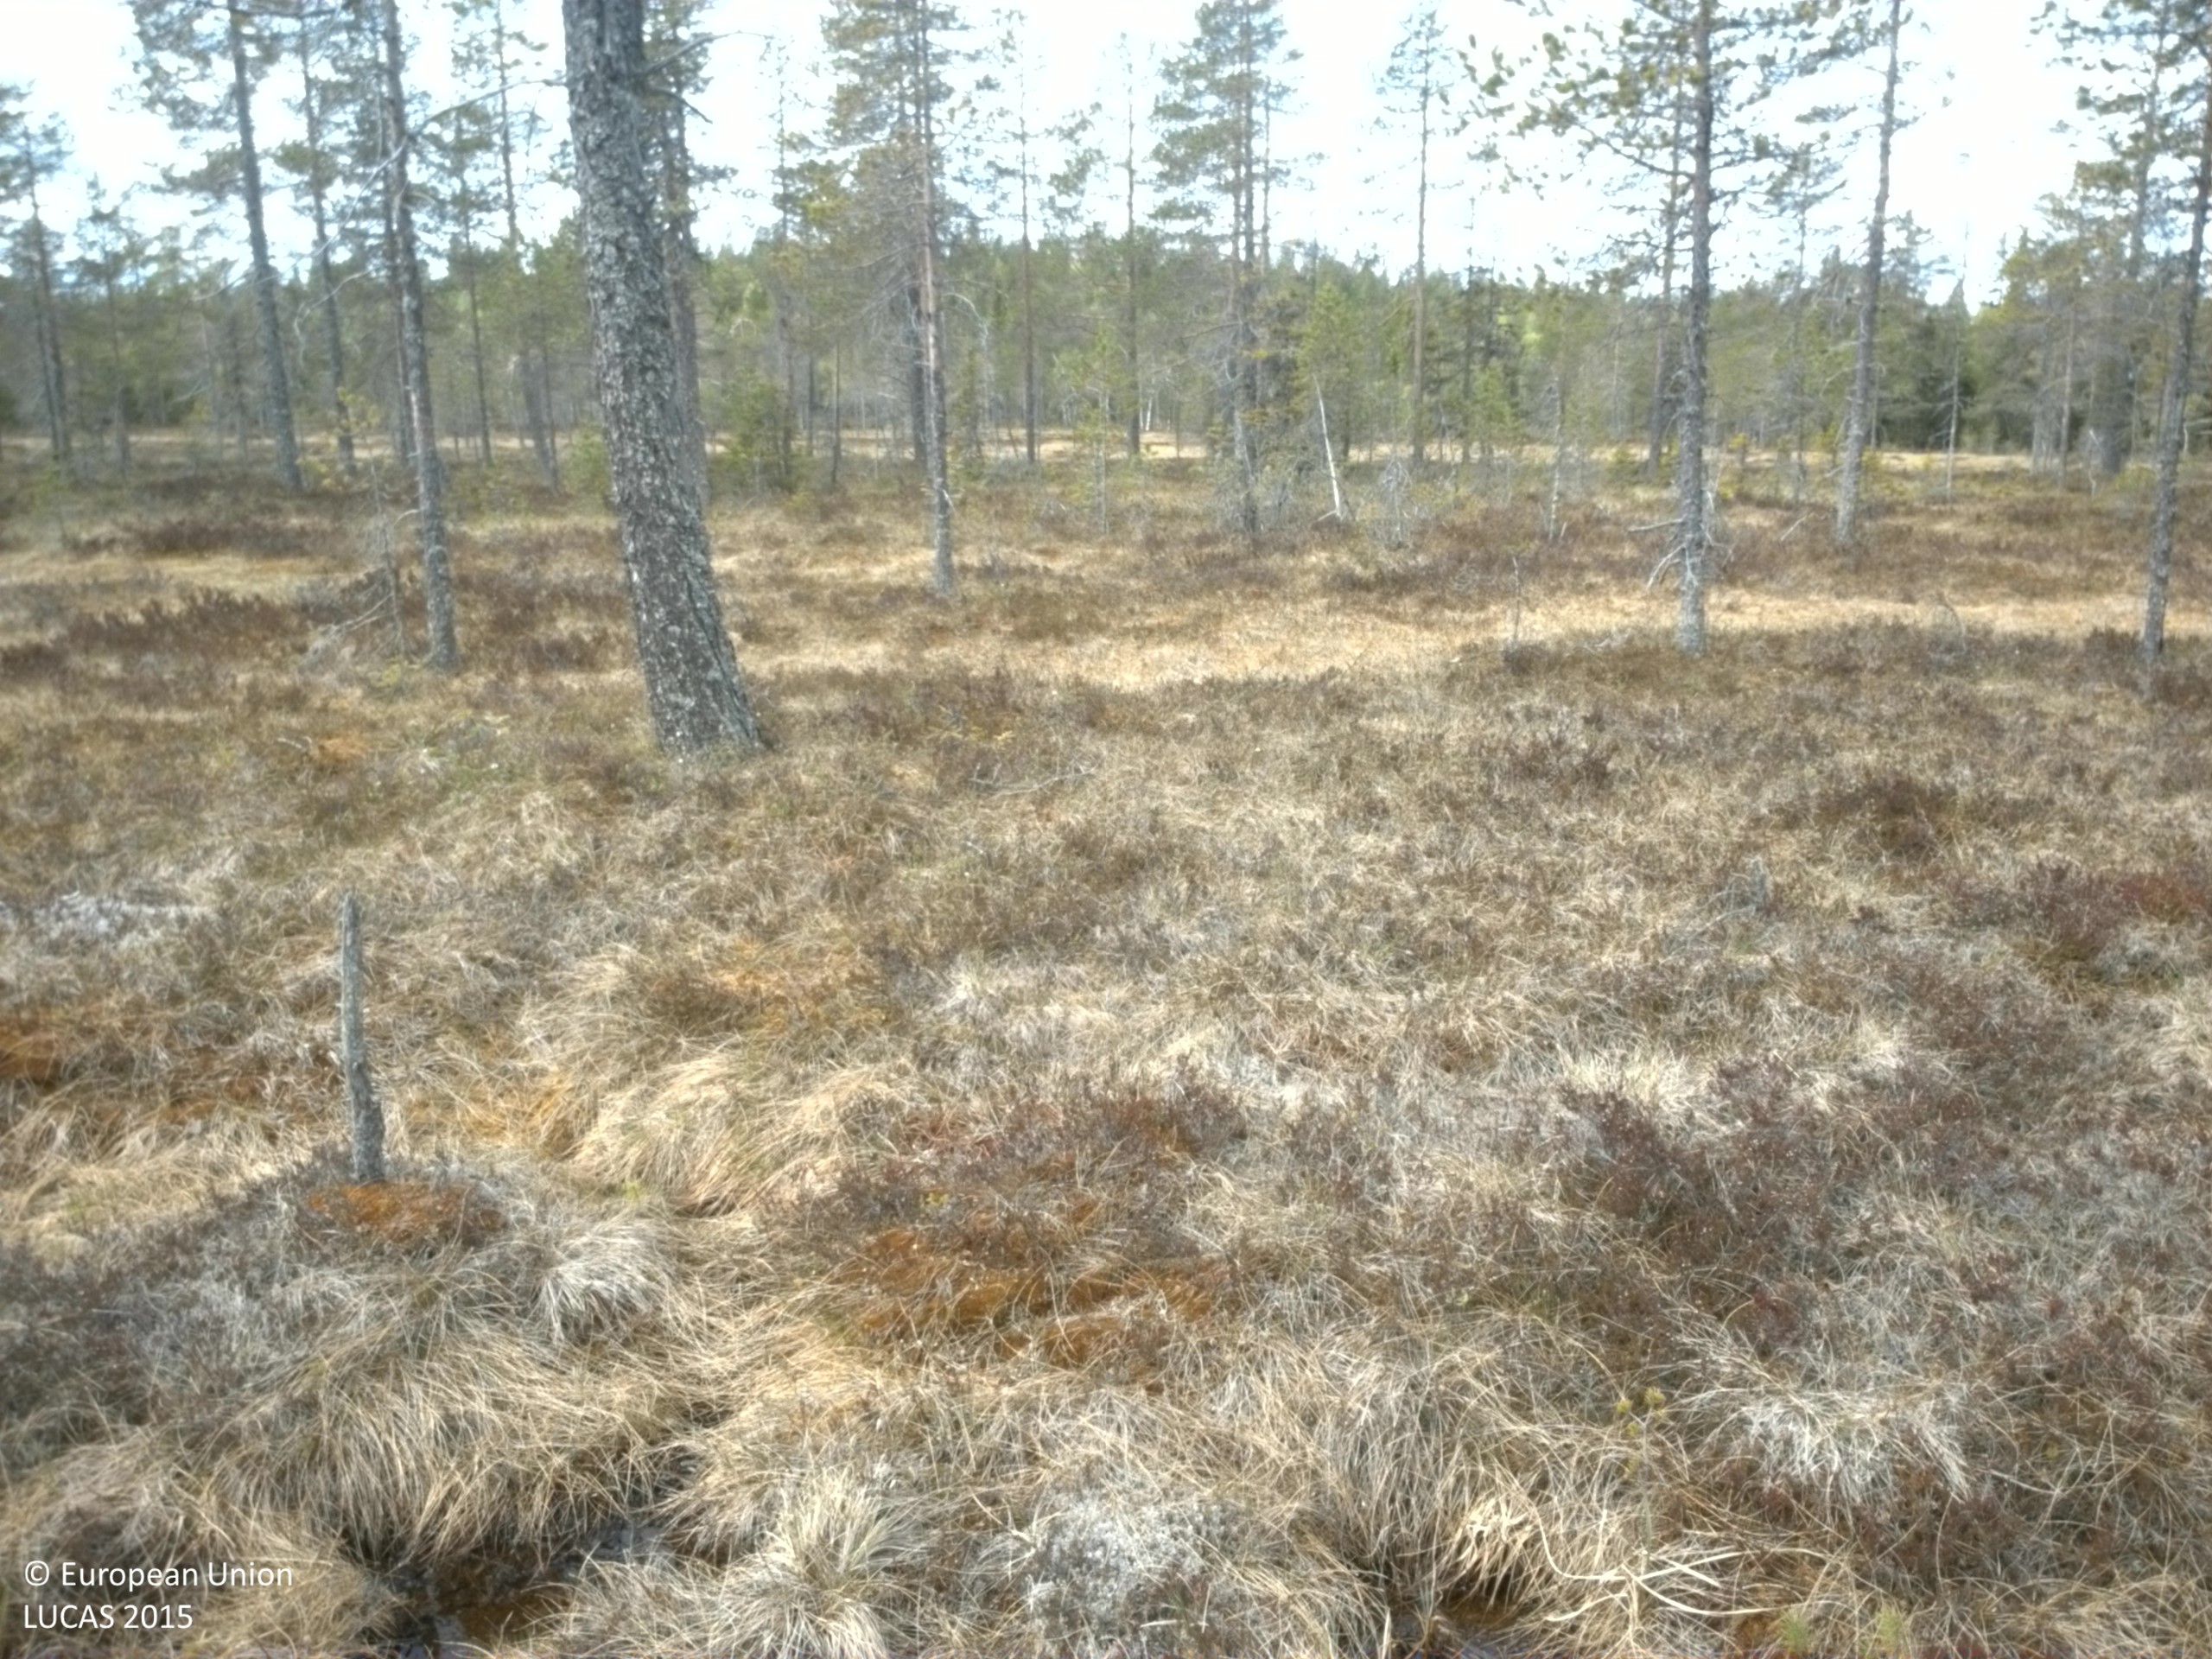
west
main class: Shrubland
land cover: Shrubland with sparse tree cover
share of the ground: 50 - 75 %
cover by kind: shrubs 70 %, herbaceous plants 25 %, coniferous forest trees 5 %
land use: Semi-natural and natural areas not in use
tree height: > 5 m
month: June
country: SE
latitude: 62.9147
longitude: 17.1233
